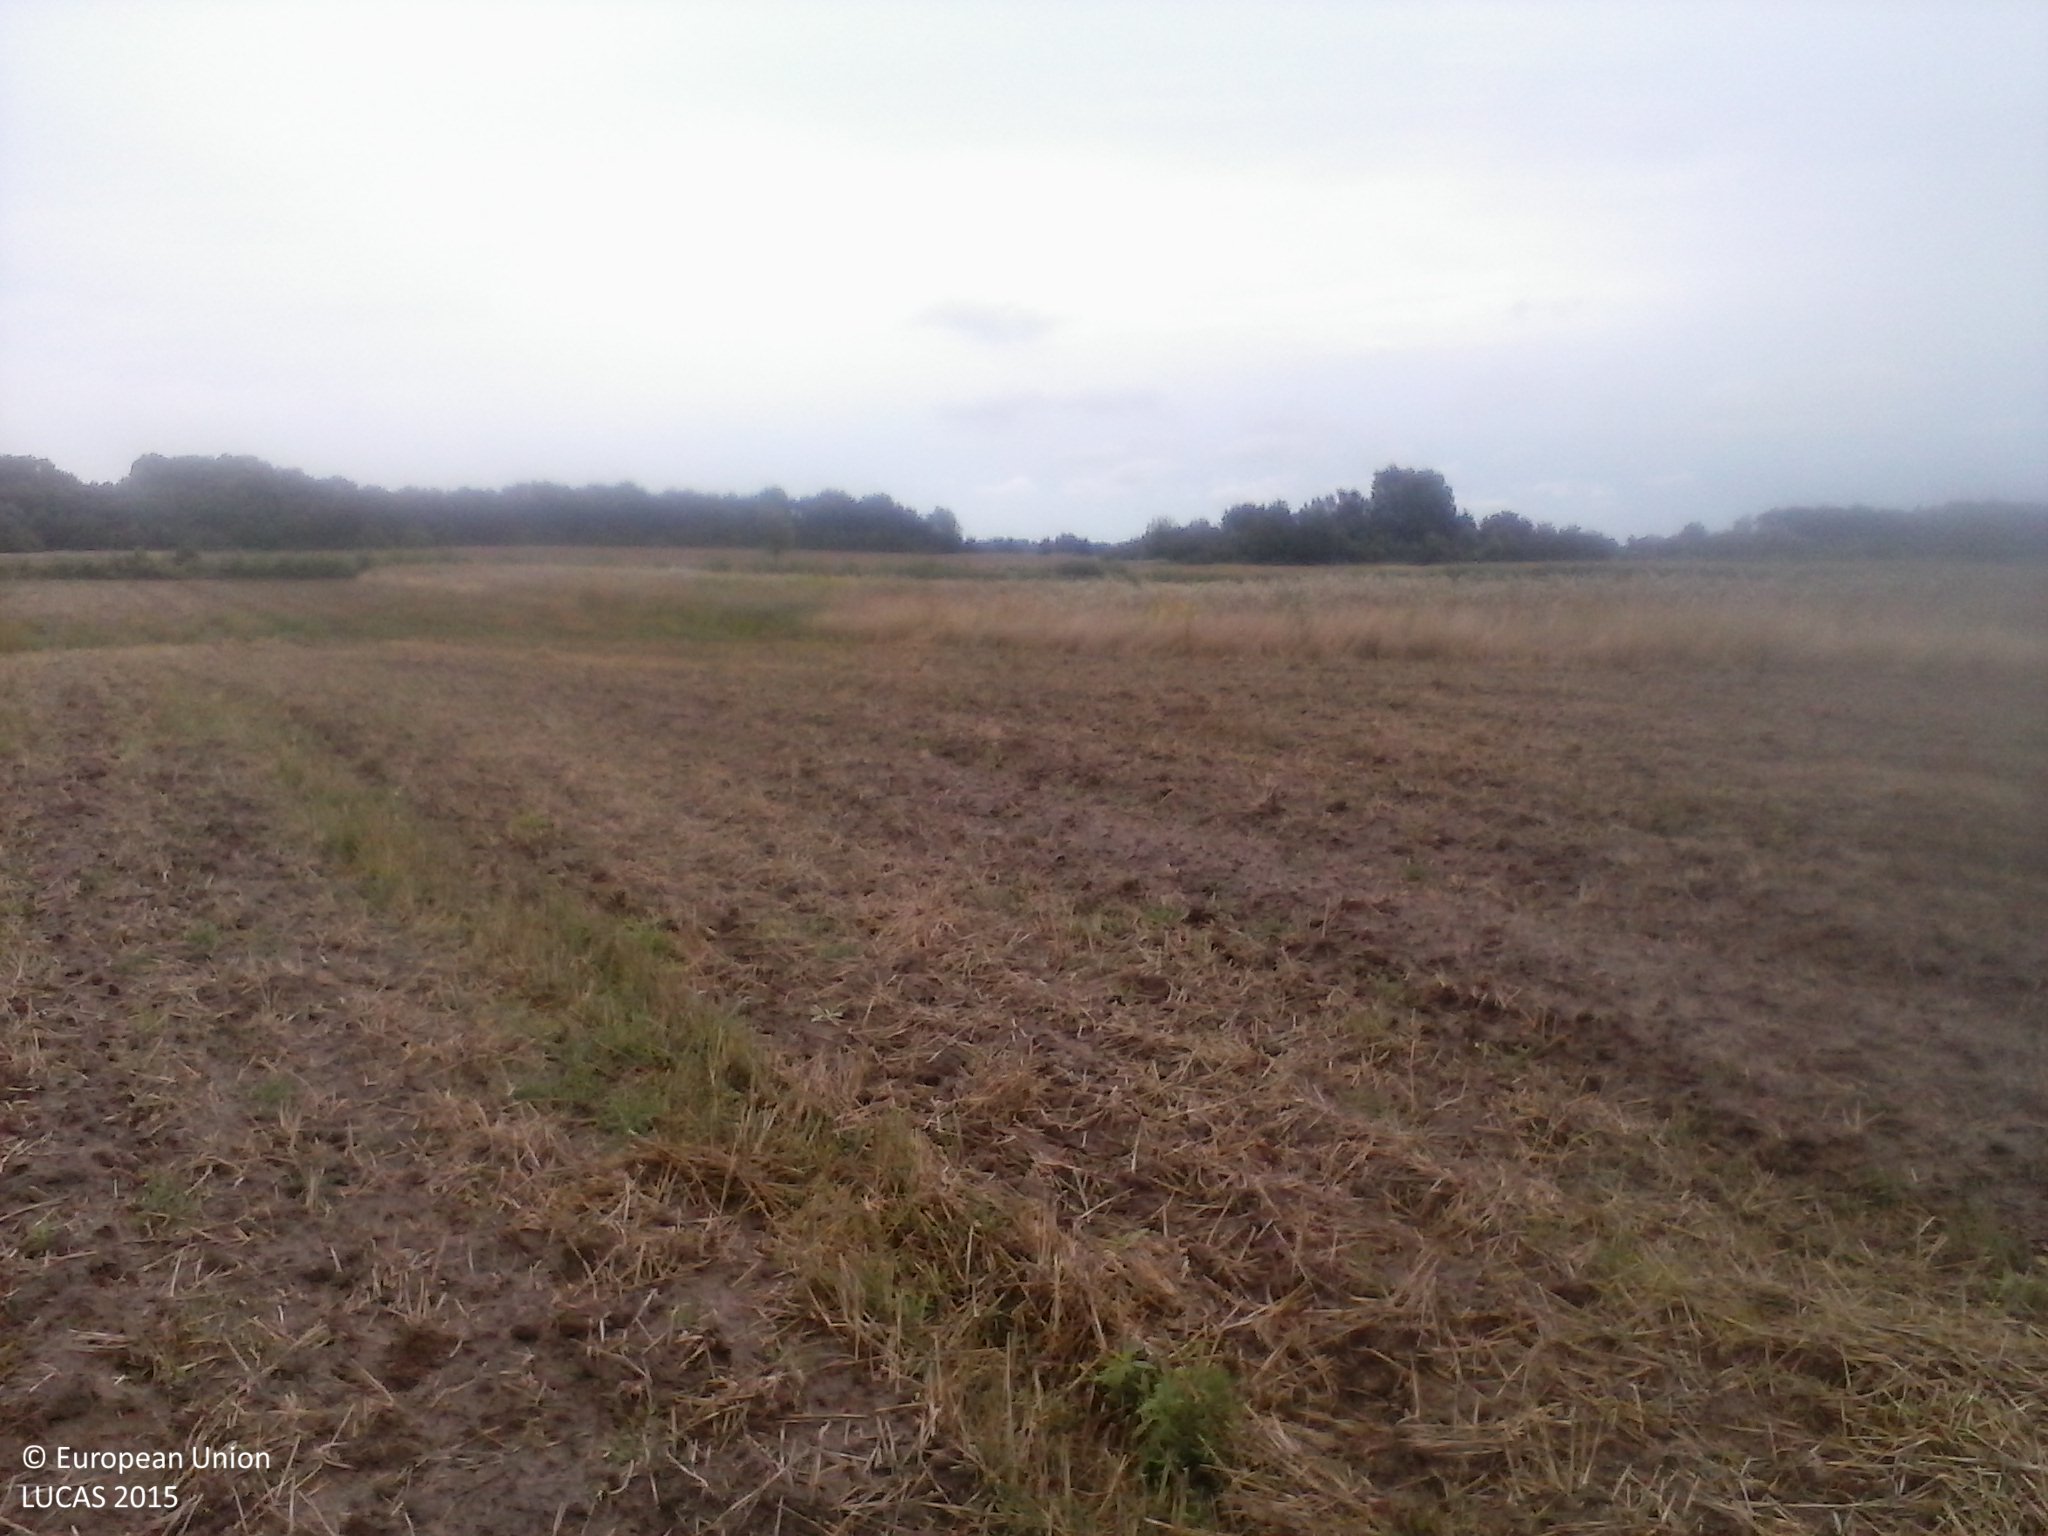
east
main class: Cropland
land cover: Common wheat
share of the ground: < 10 %
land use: Agriculture (excluding fallow land and kitchen gardens)
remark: Harvested field
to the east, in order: Common wheat; Tracks; Abandoned hedges; Ditches and canals; Abandoned hedges; Common wheat; Grass margins; Ditches and canals; Grass margins; Common wheat
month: July
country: HU
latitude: 45.9445
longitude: 17.7309
